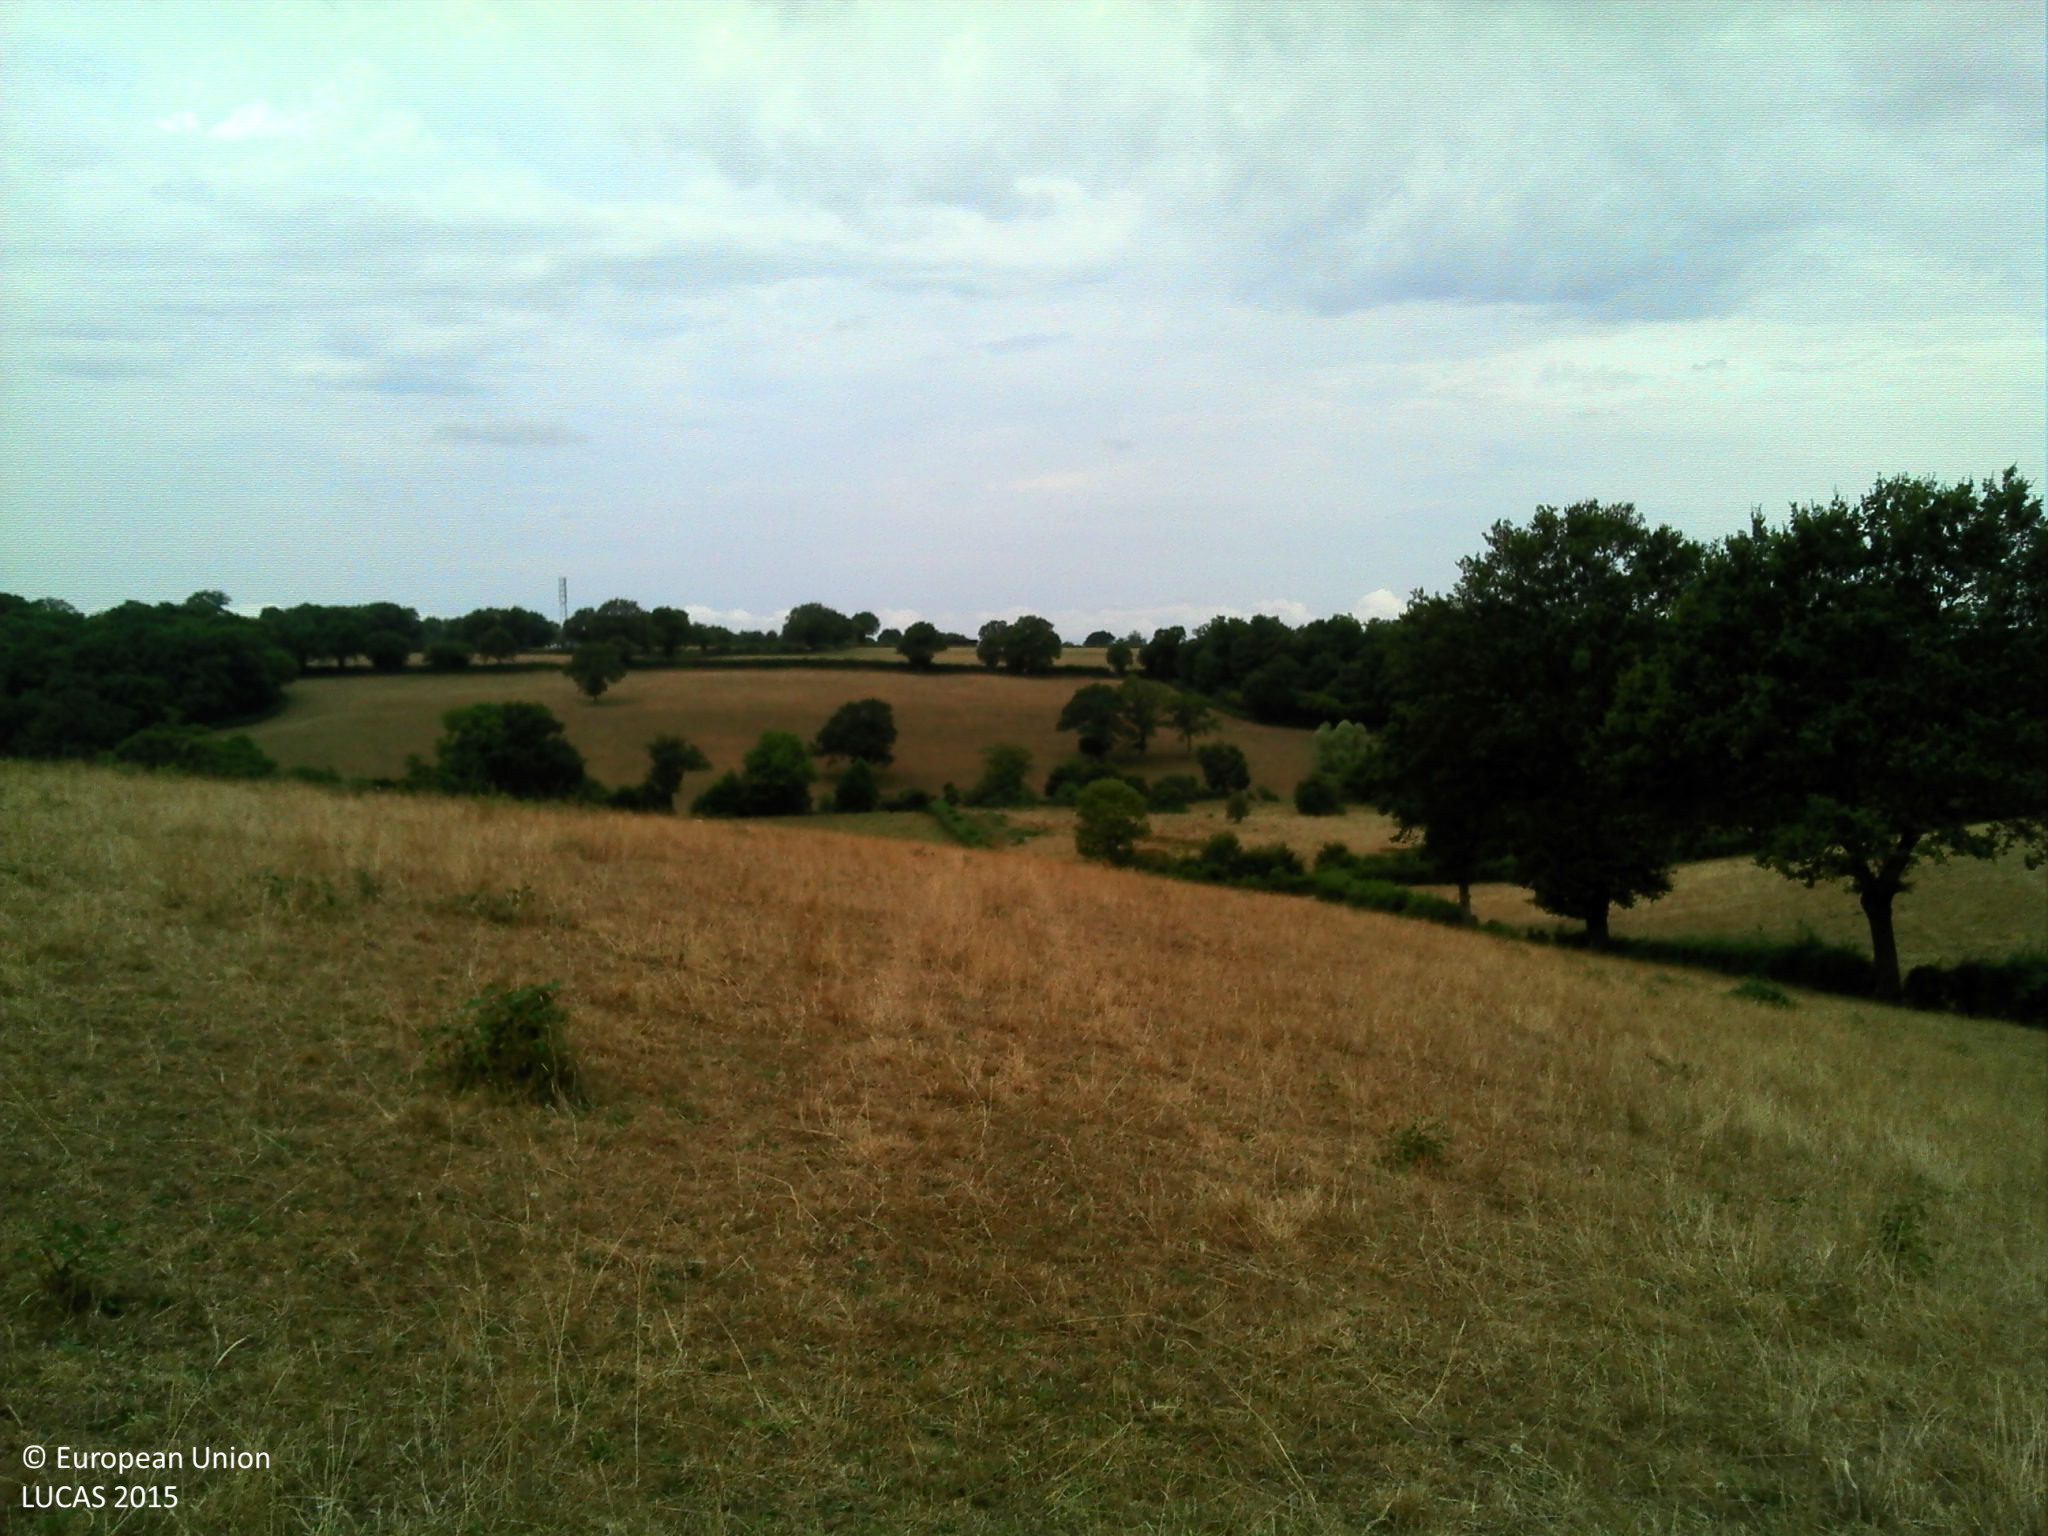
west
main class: Grassland
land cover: Grassland without tree/shrub cover
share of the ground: > 75 %
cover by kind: herbaceous plants 100 %
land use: Agriculture (excluding fallow land and kitchen gardens)
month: July
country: FR
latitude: 46.6268
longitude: 2.9831
